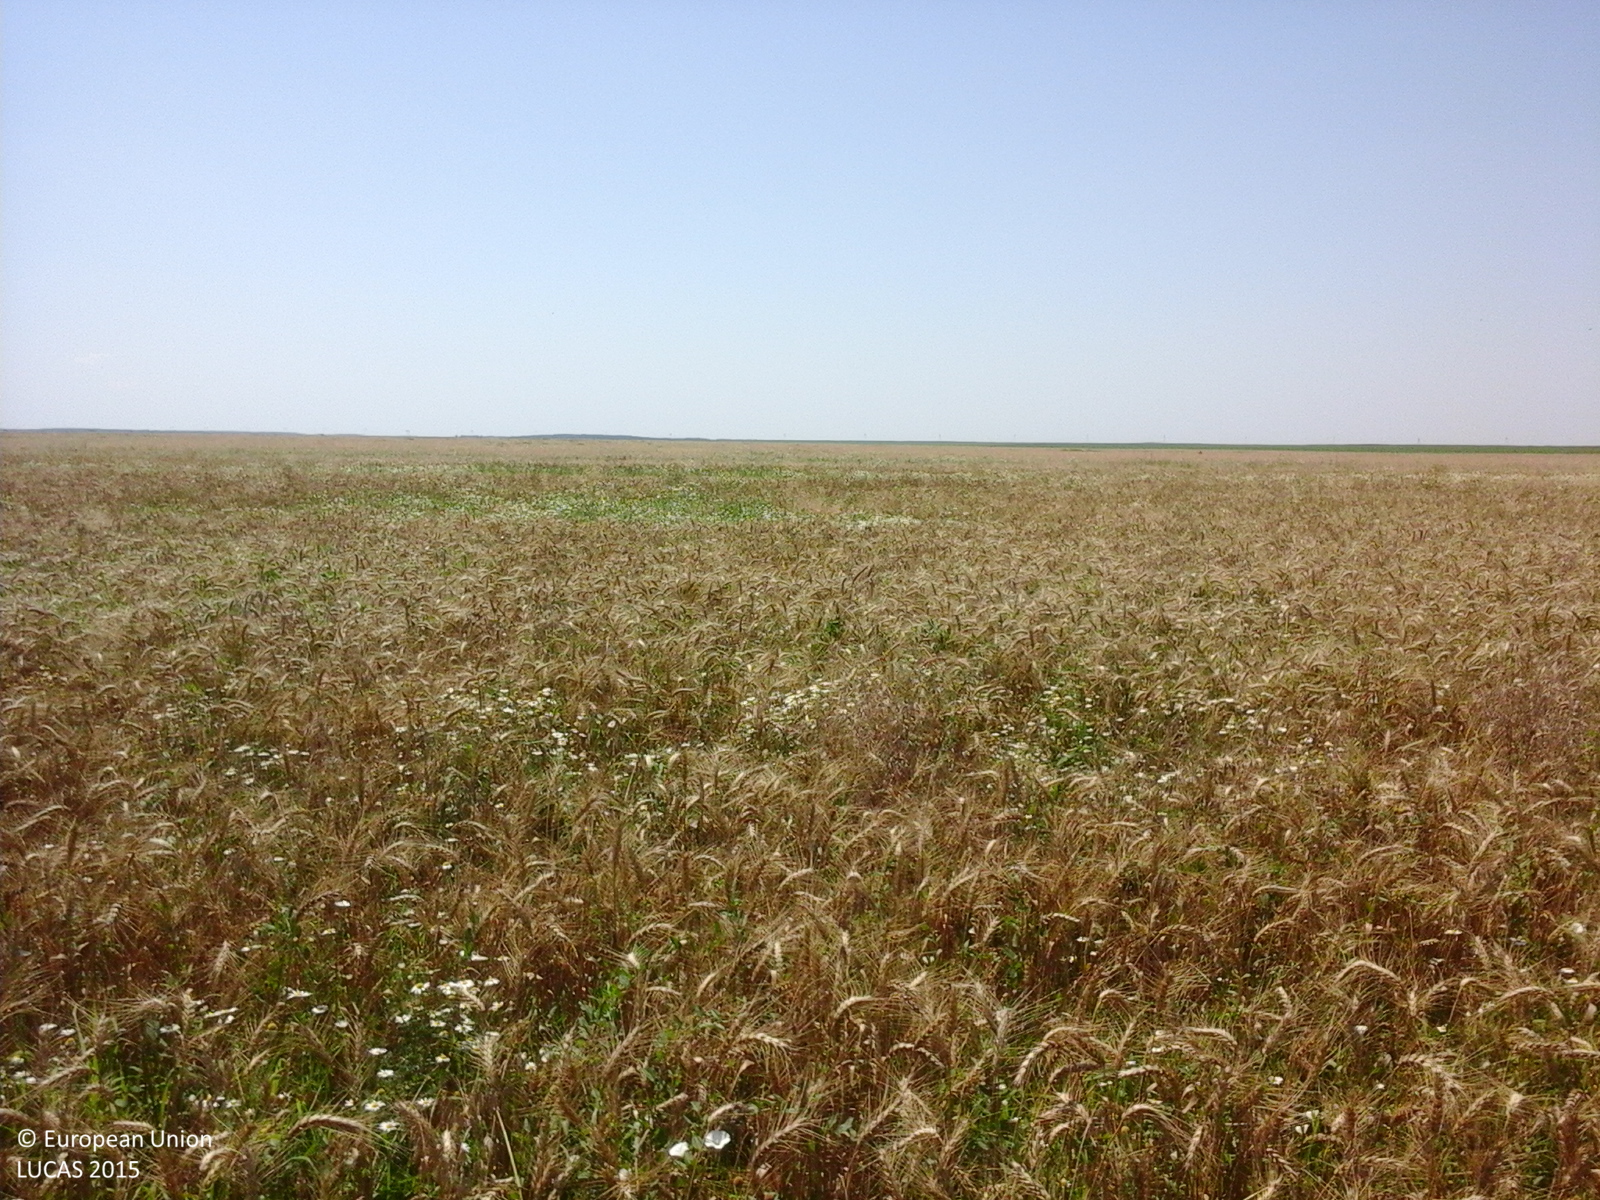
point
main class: Cropland
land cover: Common wheat
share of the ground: > 75 %
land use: Agriculture (excluding fallow land and kitchen gardens)
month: July
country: RO
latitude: 44.4199
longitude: 24.5272
